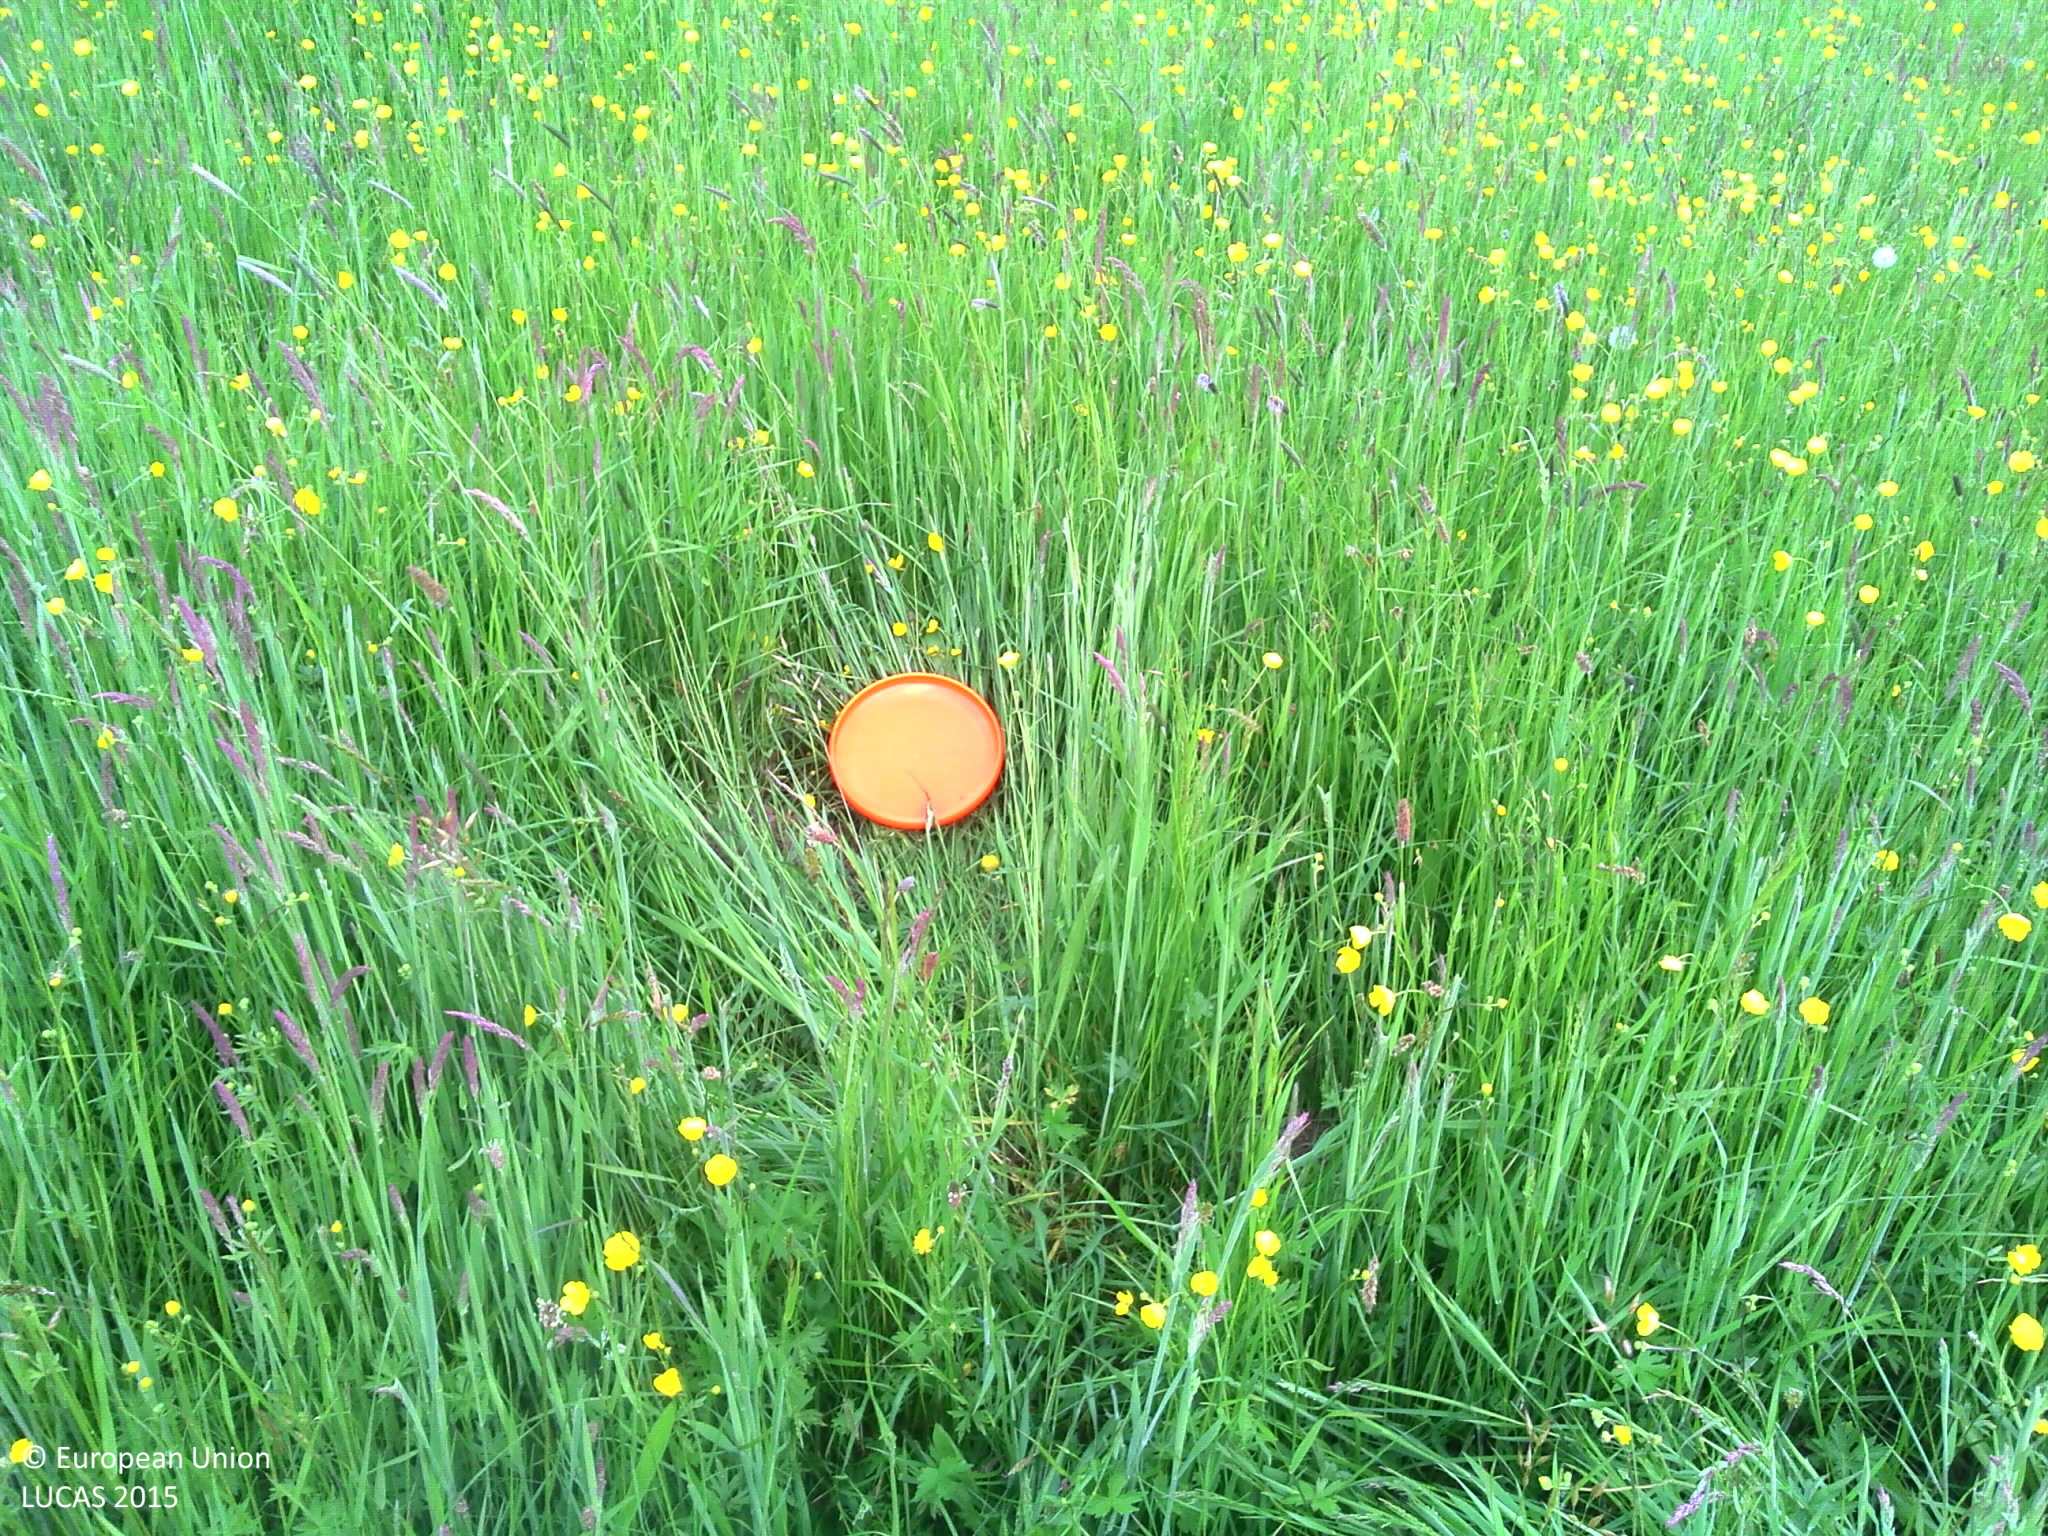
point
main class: Grassland
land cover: Grassland without tree/shrub cover
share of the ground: > 75 %
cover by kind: herbaceous plants 100 %
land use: Agriculture (excluding fallow land and kitchen gardens)
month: May
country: LU
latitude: 49.6109
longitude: 6.0274
